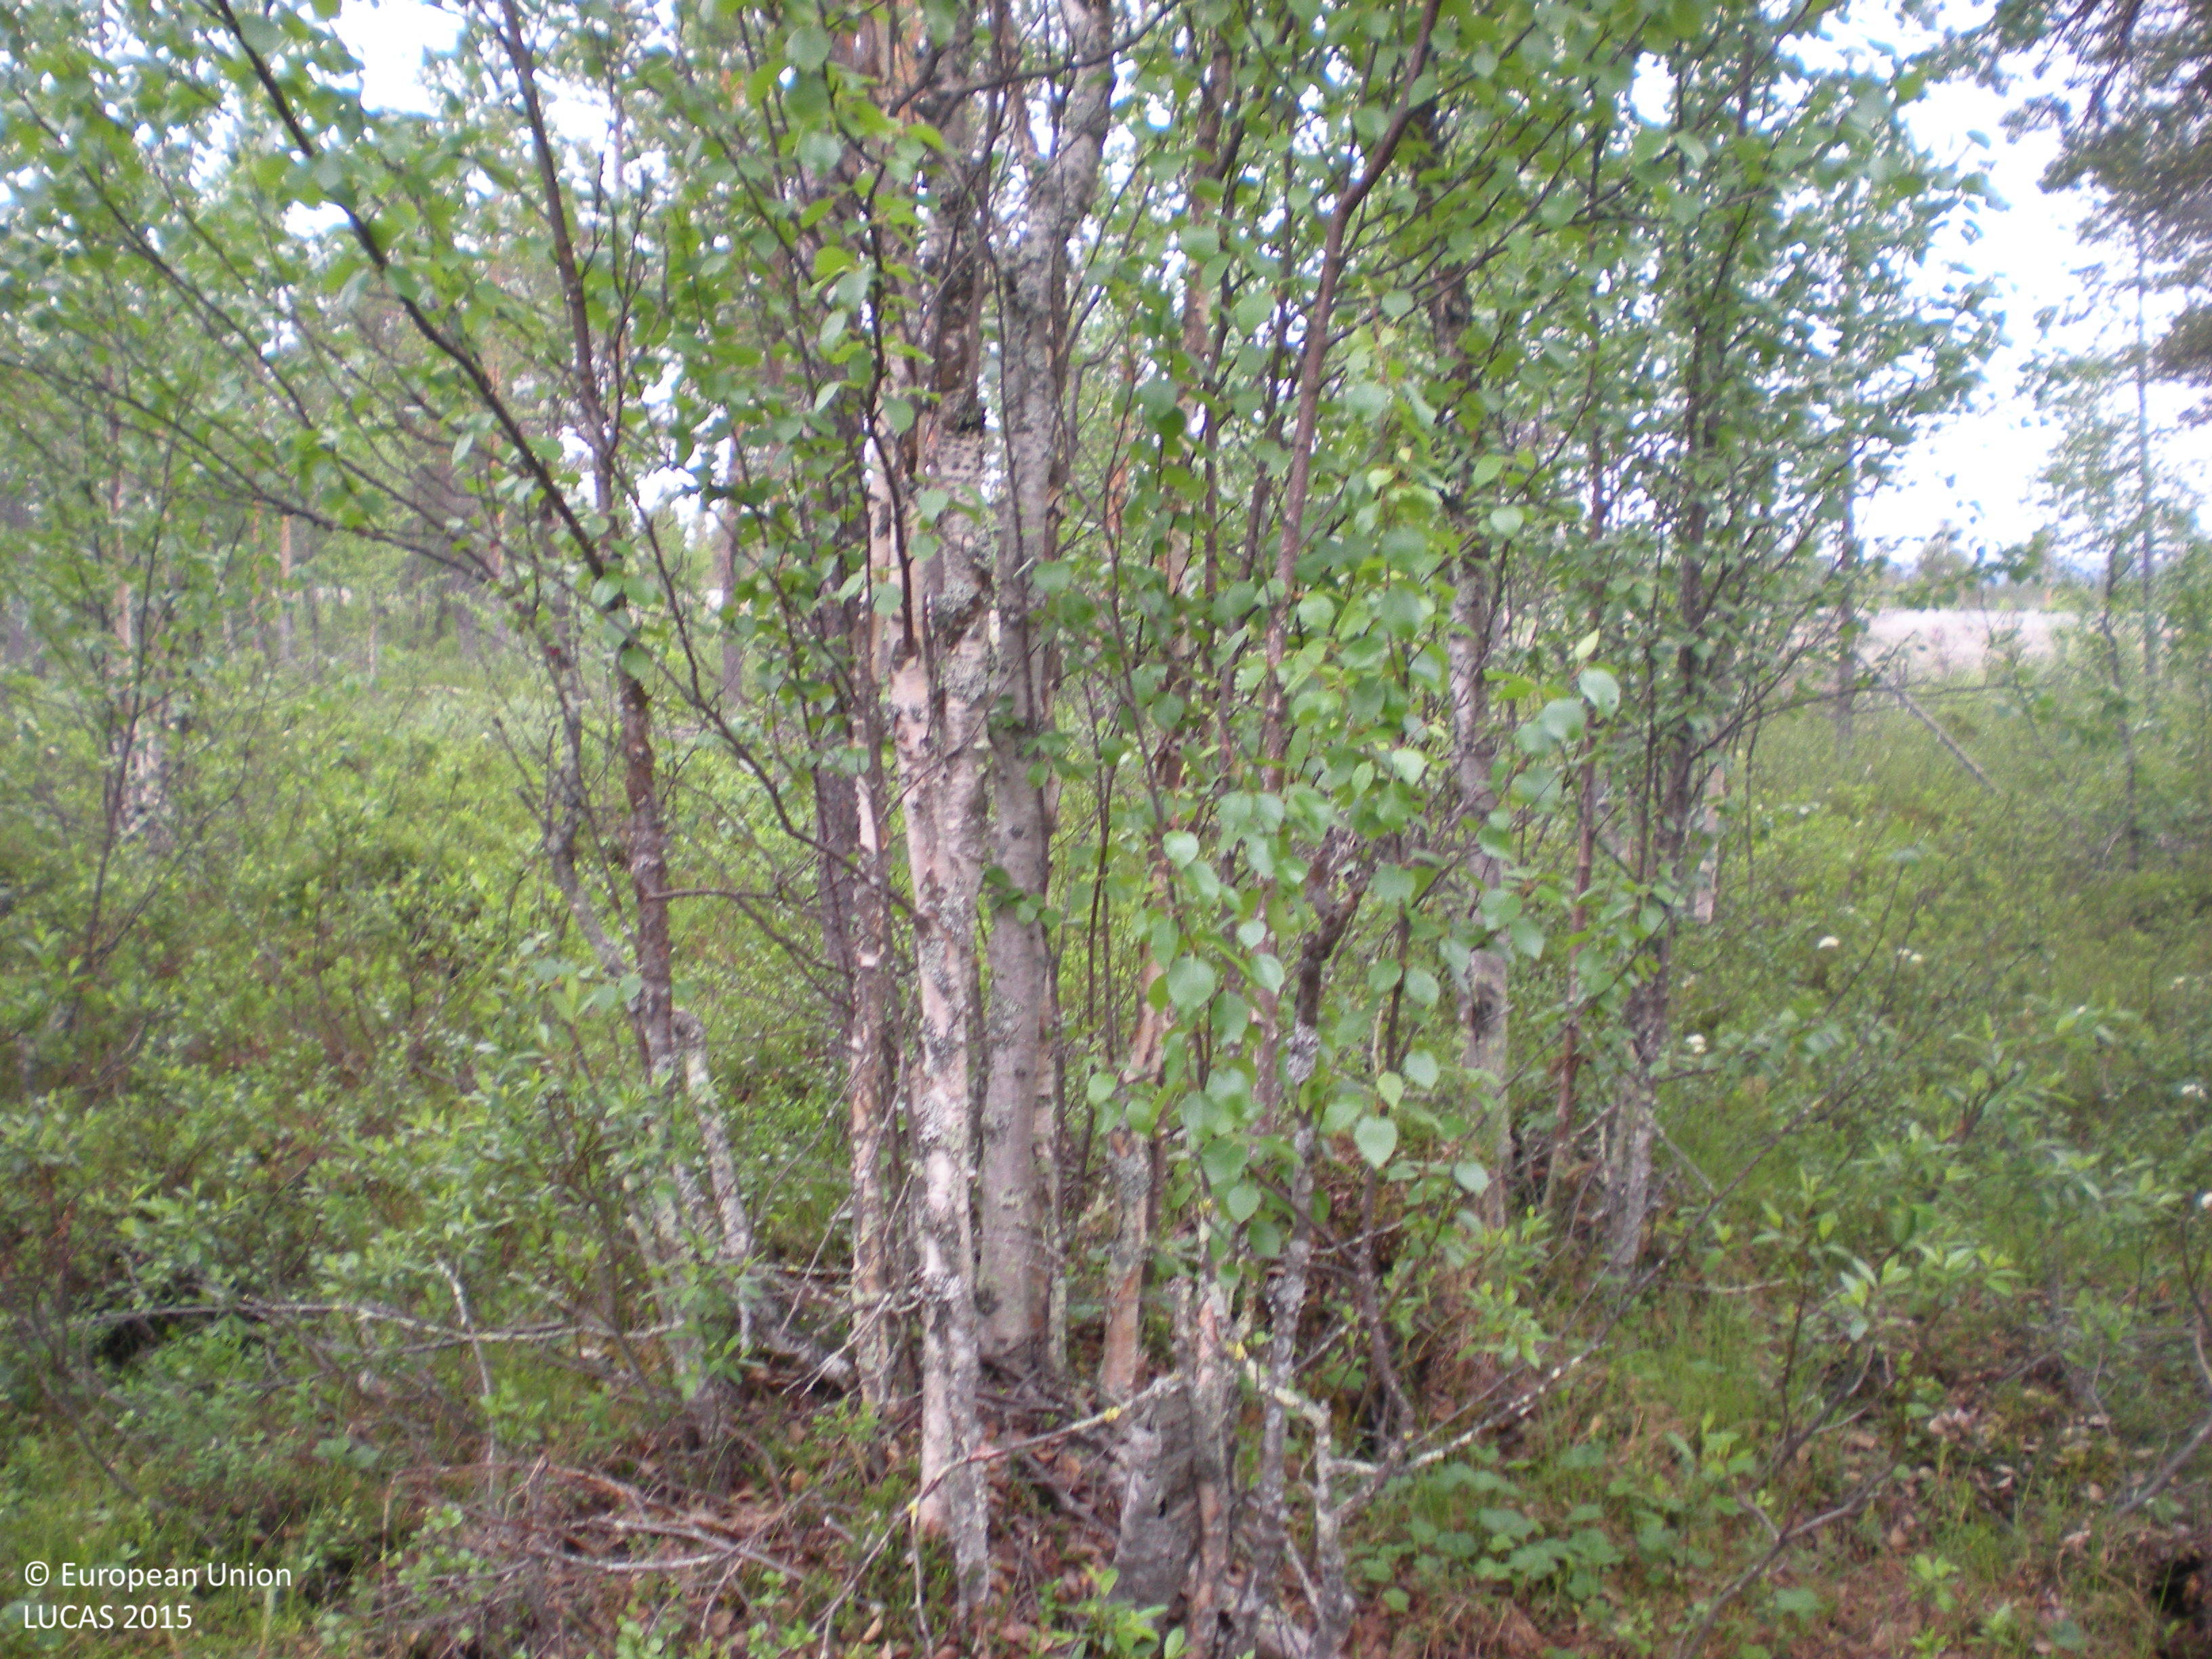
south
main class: Woodland
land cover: Pine dominated mixed woodland
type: mire and swamp forests
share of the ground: 25 - 50 %
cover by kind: broadleaved forest trees 30 %, coniferous forest trees 25 %, shrubs 20 %, herbaceous plants 15 %, lichens and mosses 5 %
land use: Forestry
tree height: < 5 m
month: July
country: SE
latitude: 66.1337
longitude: 17.3751
